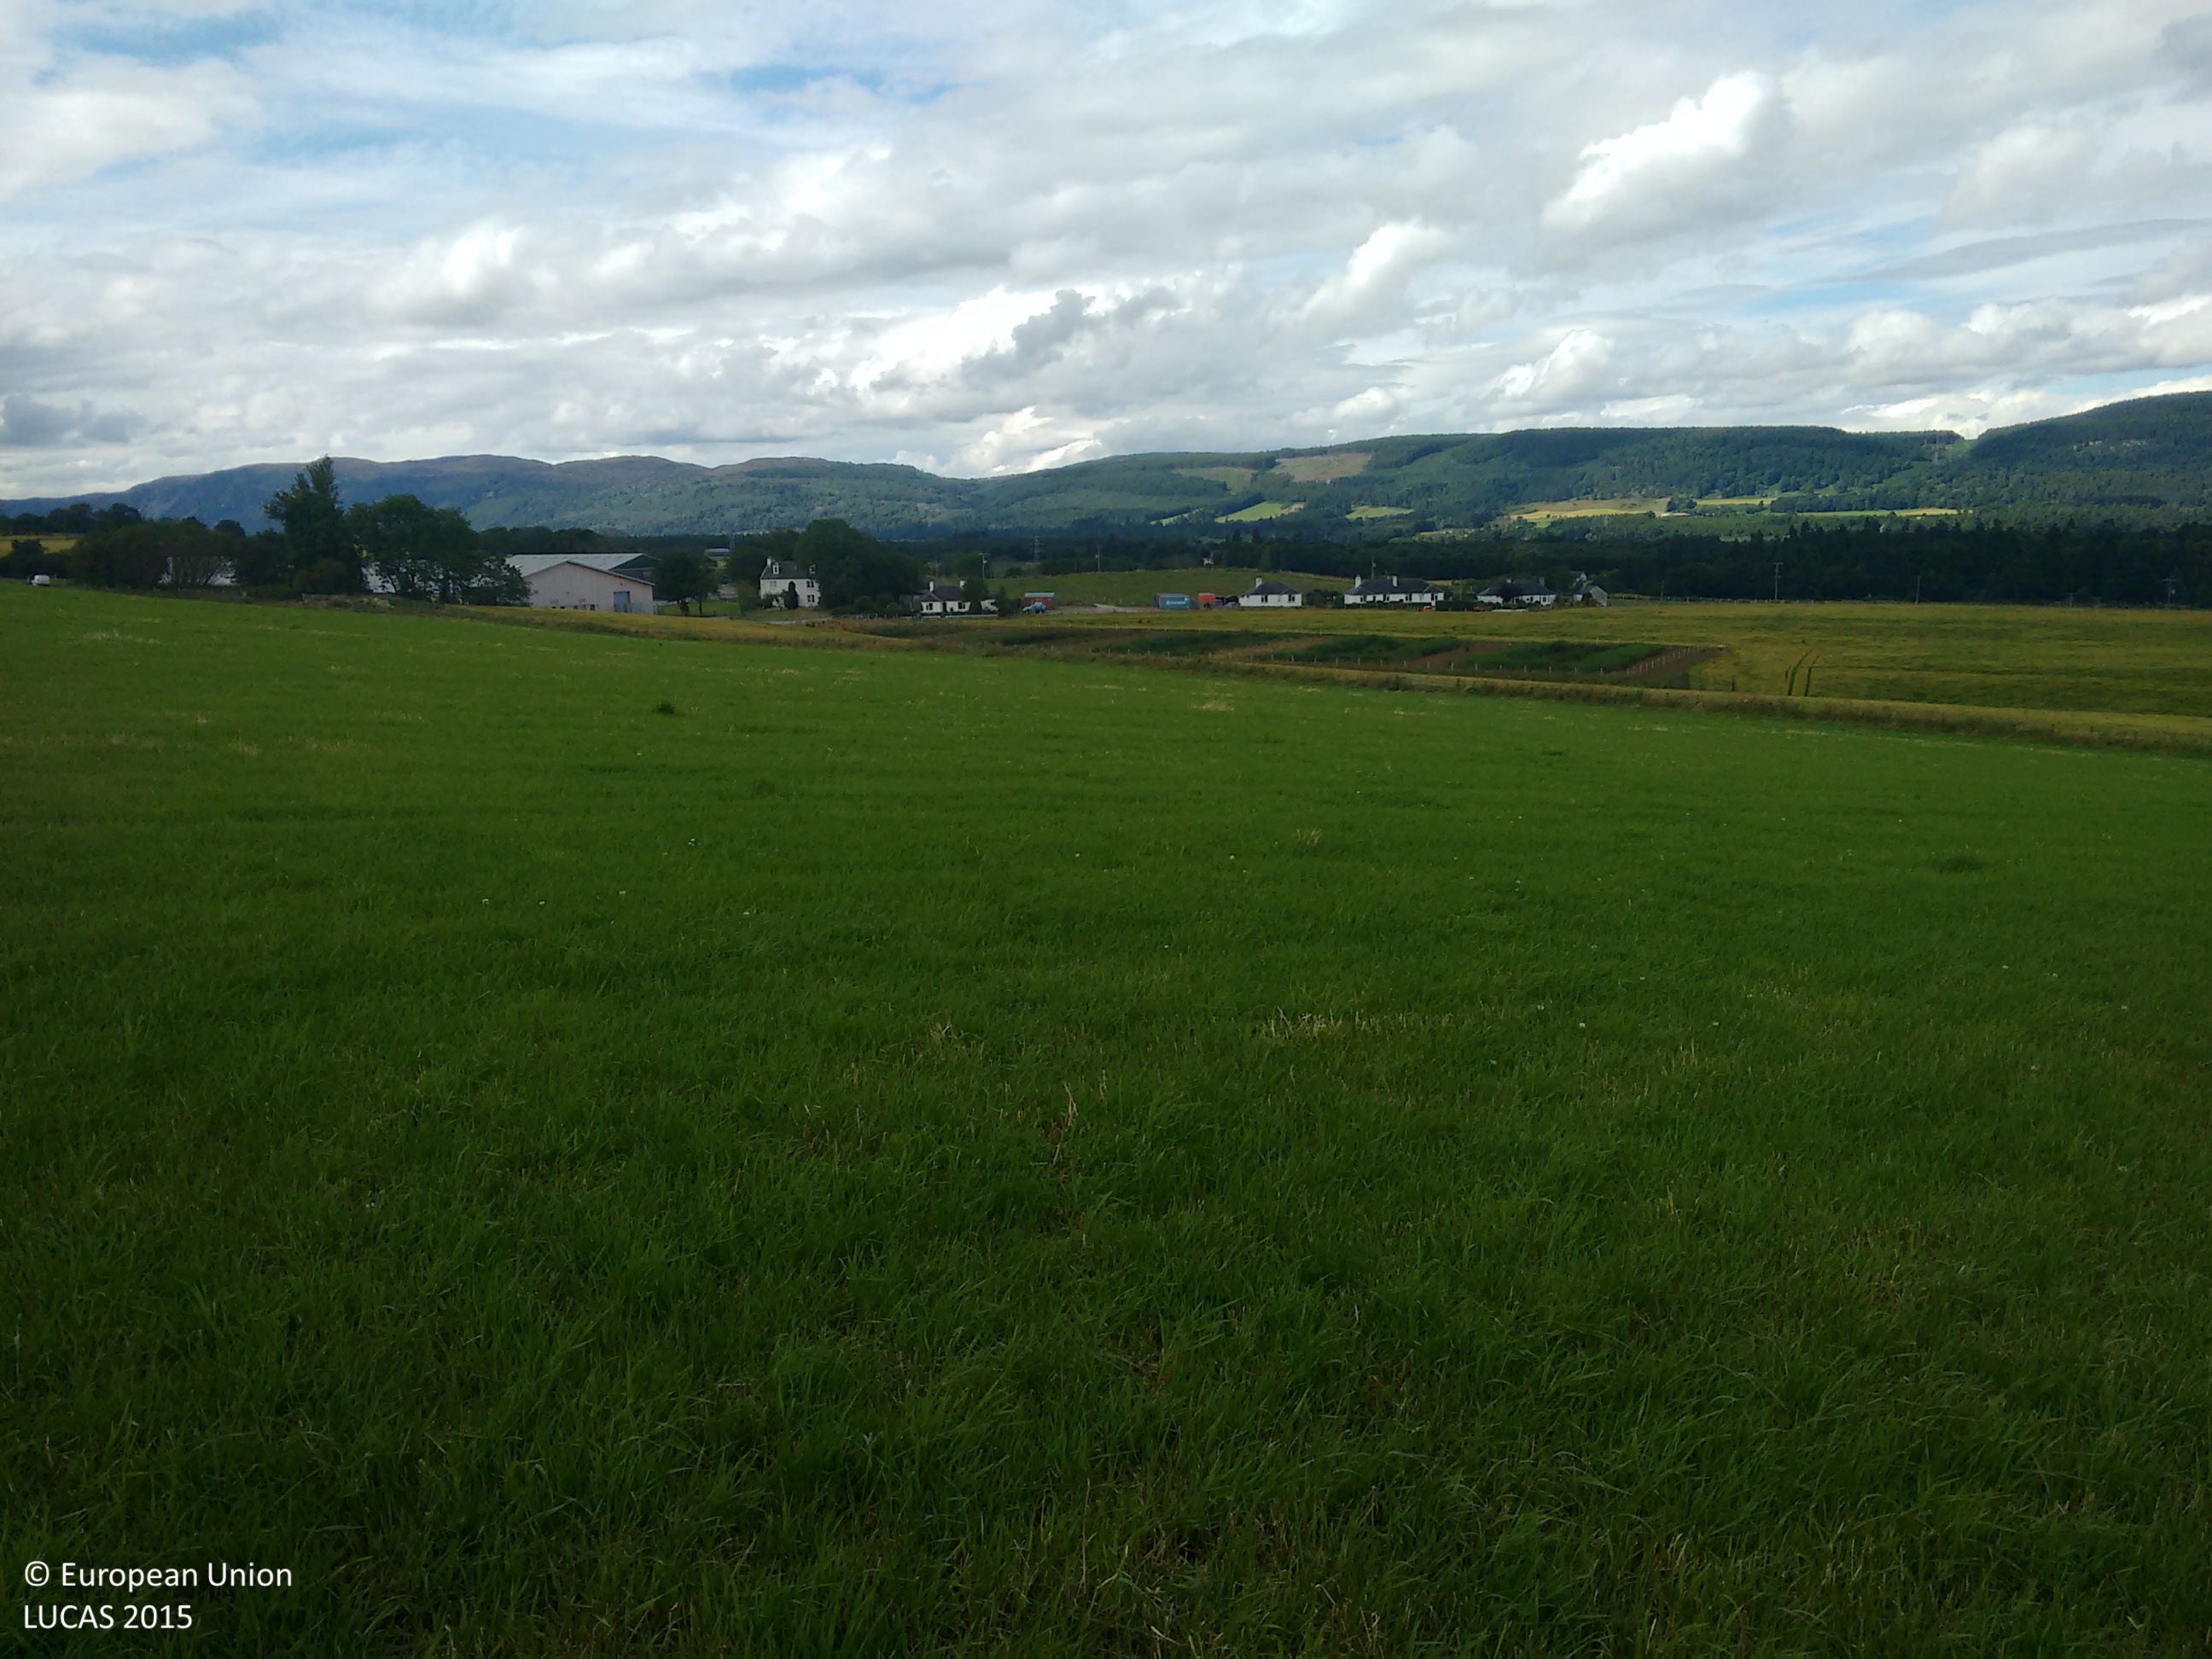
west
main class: Grassland
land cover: Grassland without tree/shrub cover
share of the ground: > 75 %
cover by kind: herbaceous plants 100 %
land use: Agriculture (excluding fallow land and kitchen gardens)
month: August
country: GB
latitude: 57.4386
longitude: -4.2291
